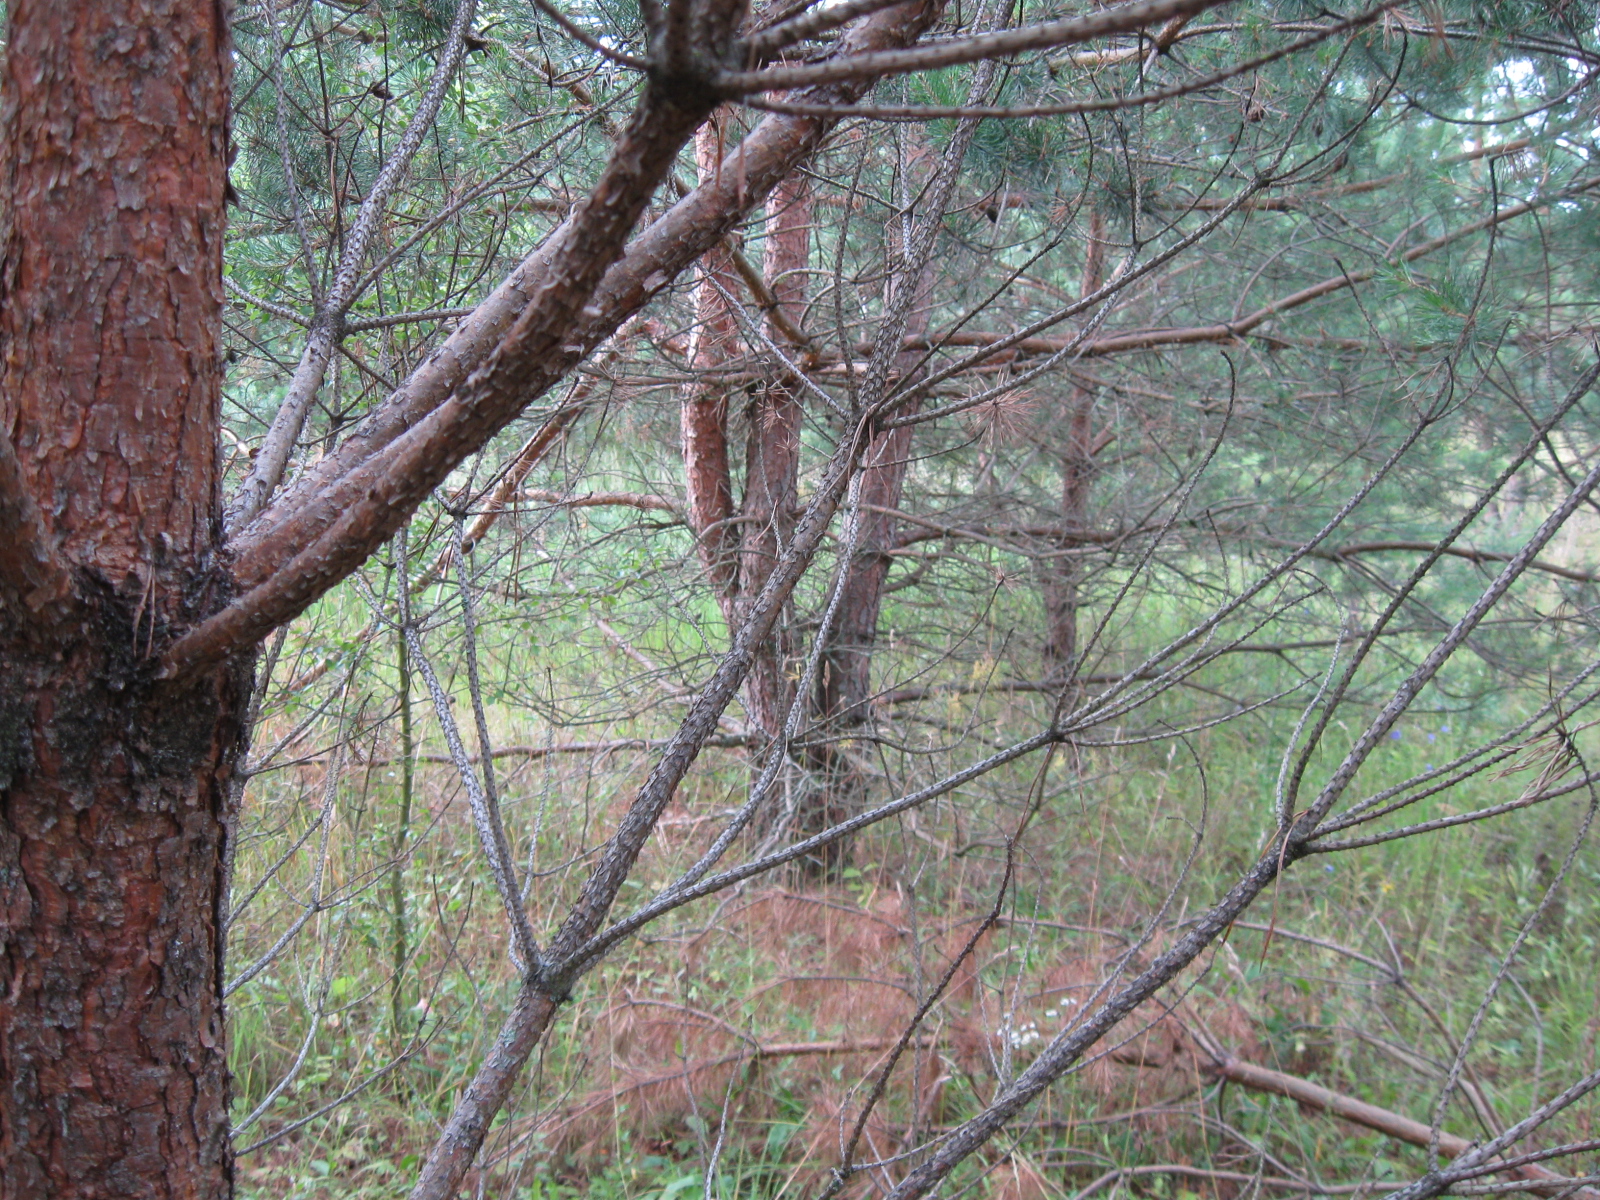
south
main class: Woodland
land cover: Pine dominated coniferous woodland
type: hemiboreal forest and nemoral coniferous forest and mixed broadleaved-coniferous forest
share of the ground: 50 - 75 %
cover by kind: coniferous forest trees 70 %, herbaceous plants 25 %, unconsolidated bare surface 5 %
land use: Forestry
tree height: < 5 m
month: July
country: LT
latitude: 54.4058
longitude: 24.3504
